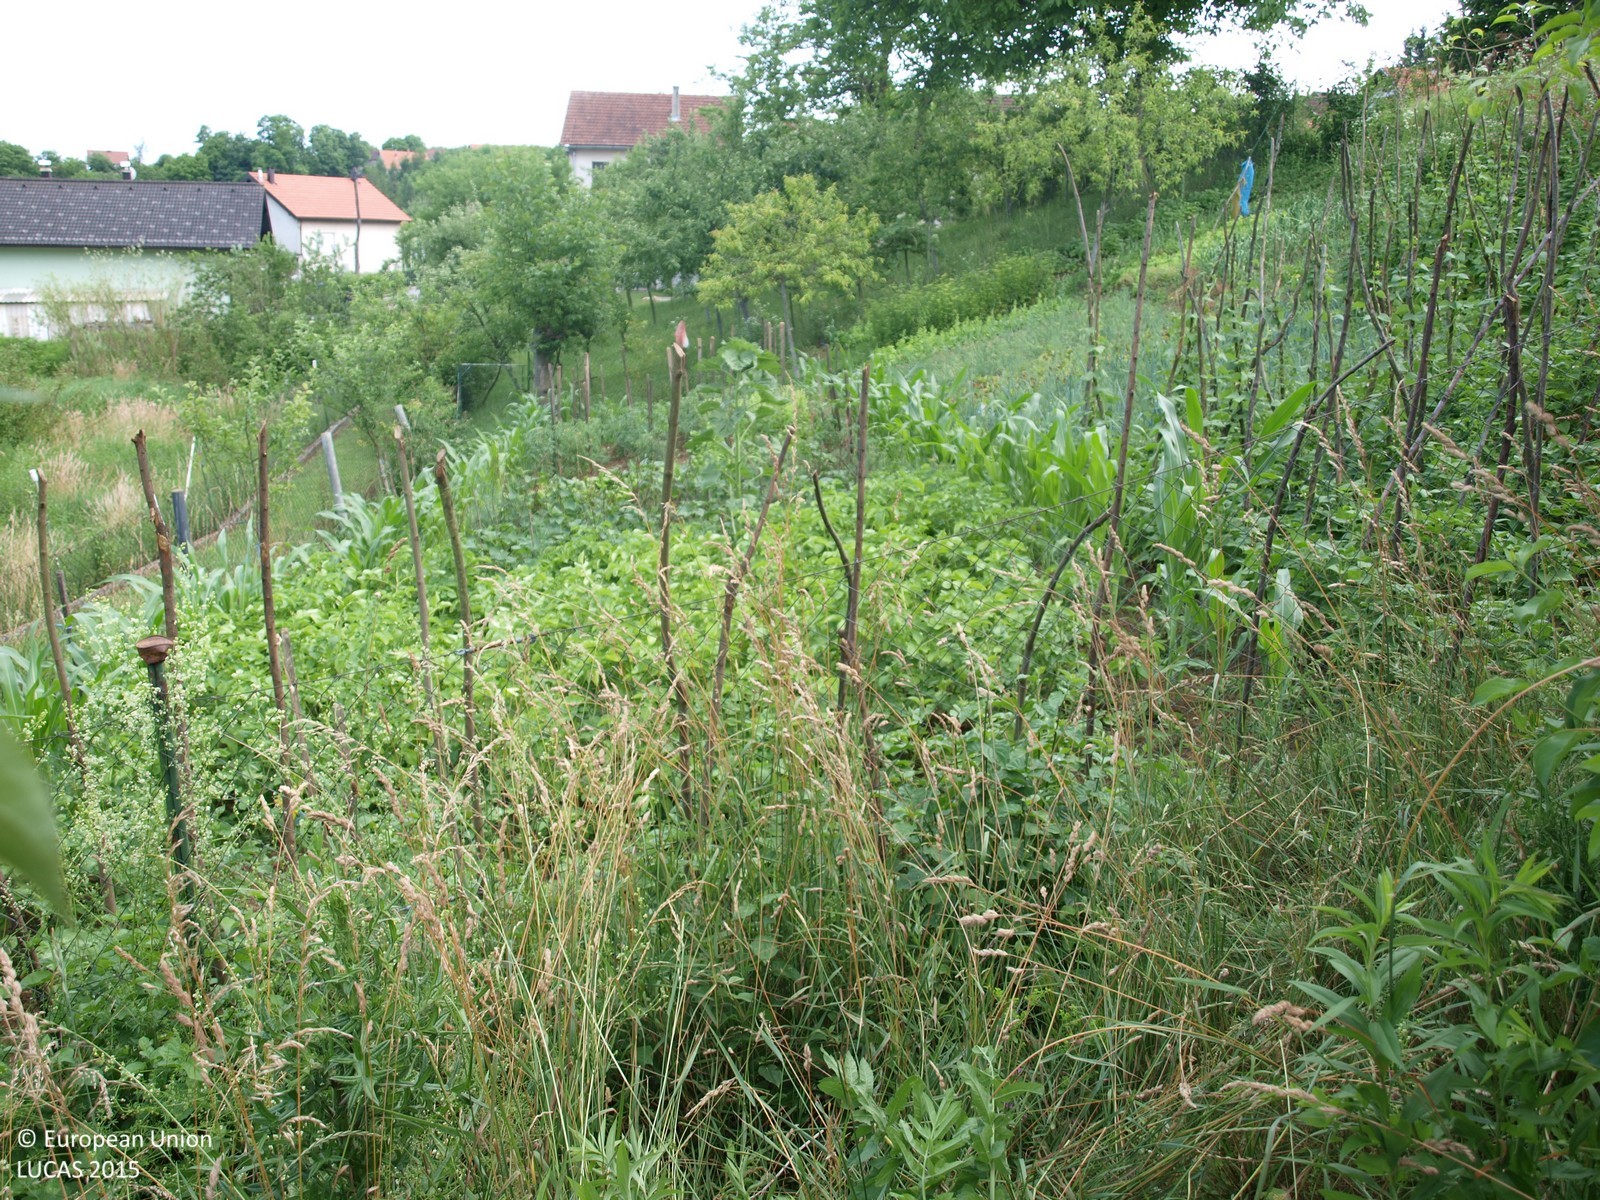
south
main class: Shrubland
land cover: Shrubland with sparse tree cover
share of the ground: > 75 %
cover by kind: shrubs 85 %, herbaceous plants 10 %, broadleaved forest trees 5 %
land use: Abandoned areas
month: June
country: HR
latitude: 46.1815
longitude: 16.3347
